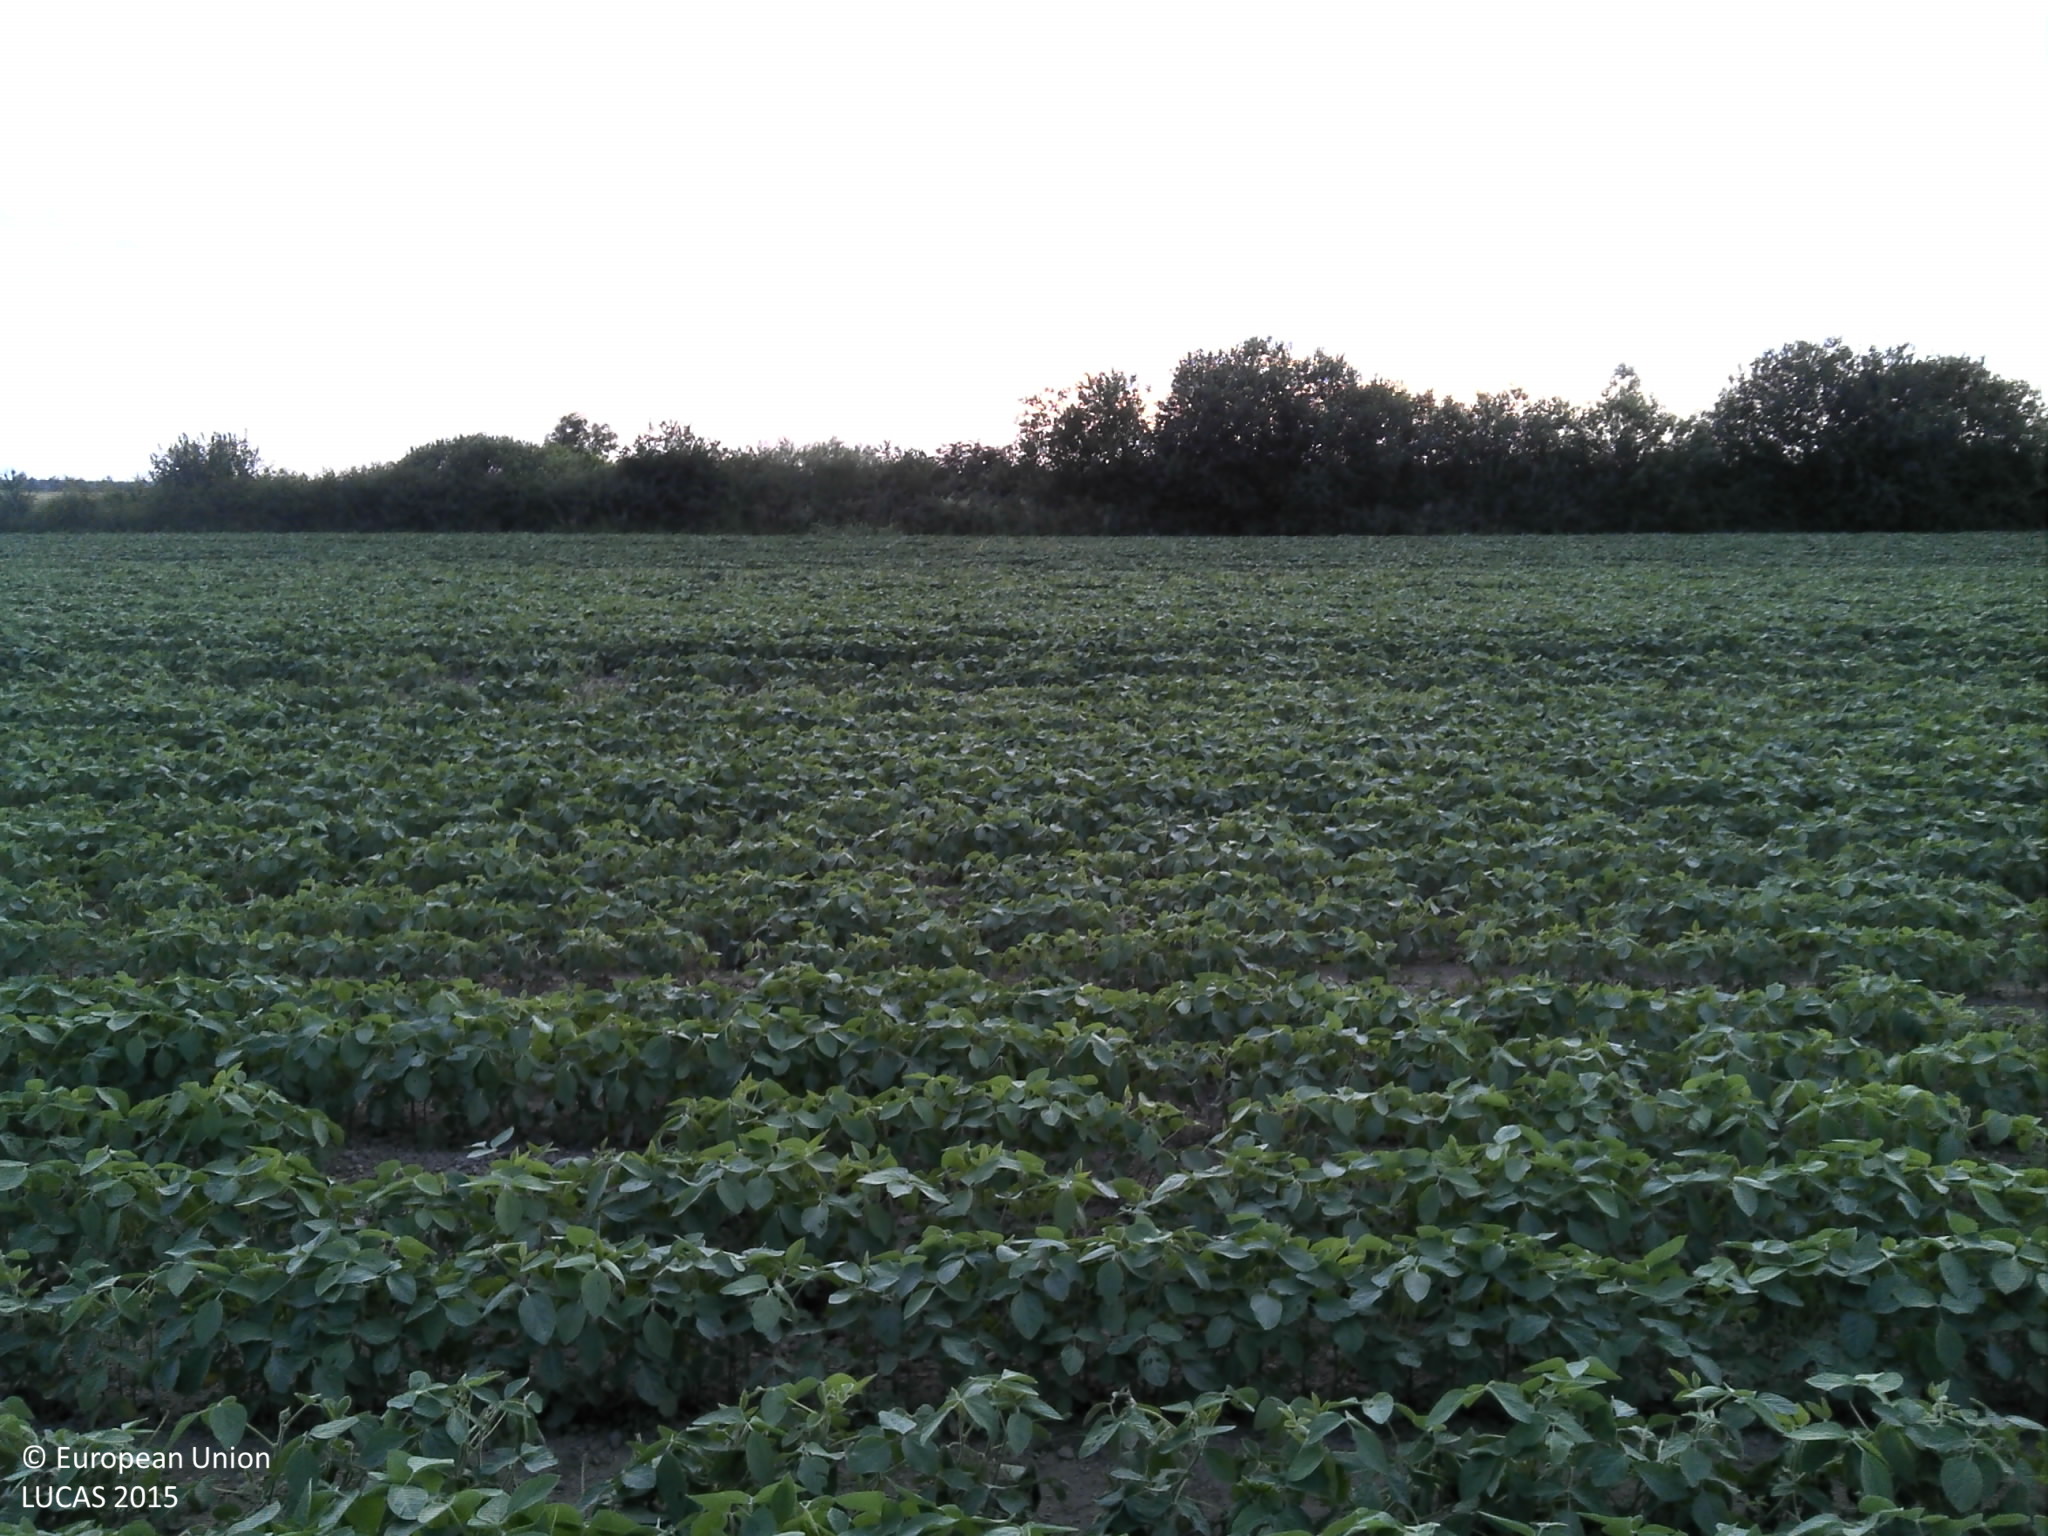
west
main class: Cropland
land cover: Soya
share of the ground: 50 - 75 %
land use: Agriculture (excluding fallow land and kitchen gardens)
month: June
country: HR
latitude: 45.7250
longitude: 18.2420
